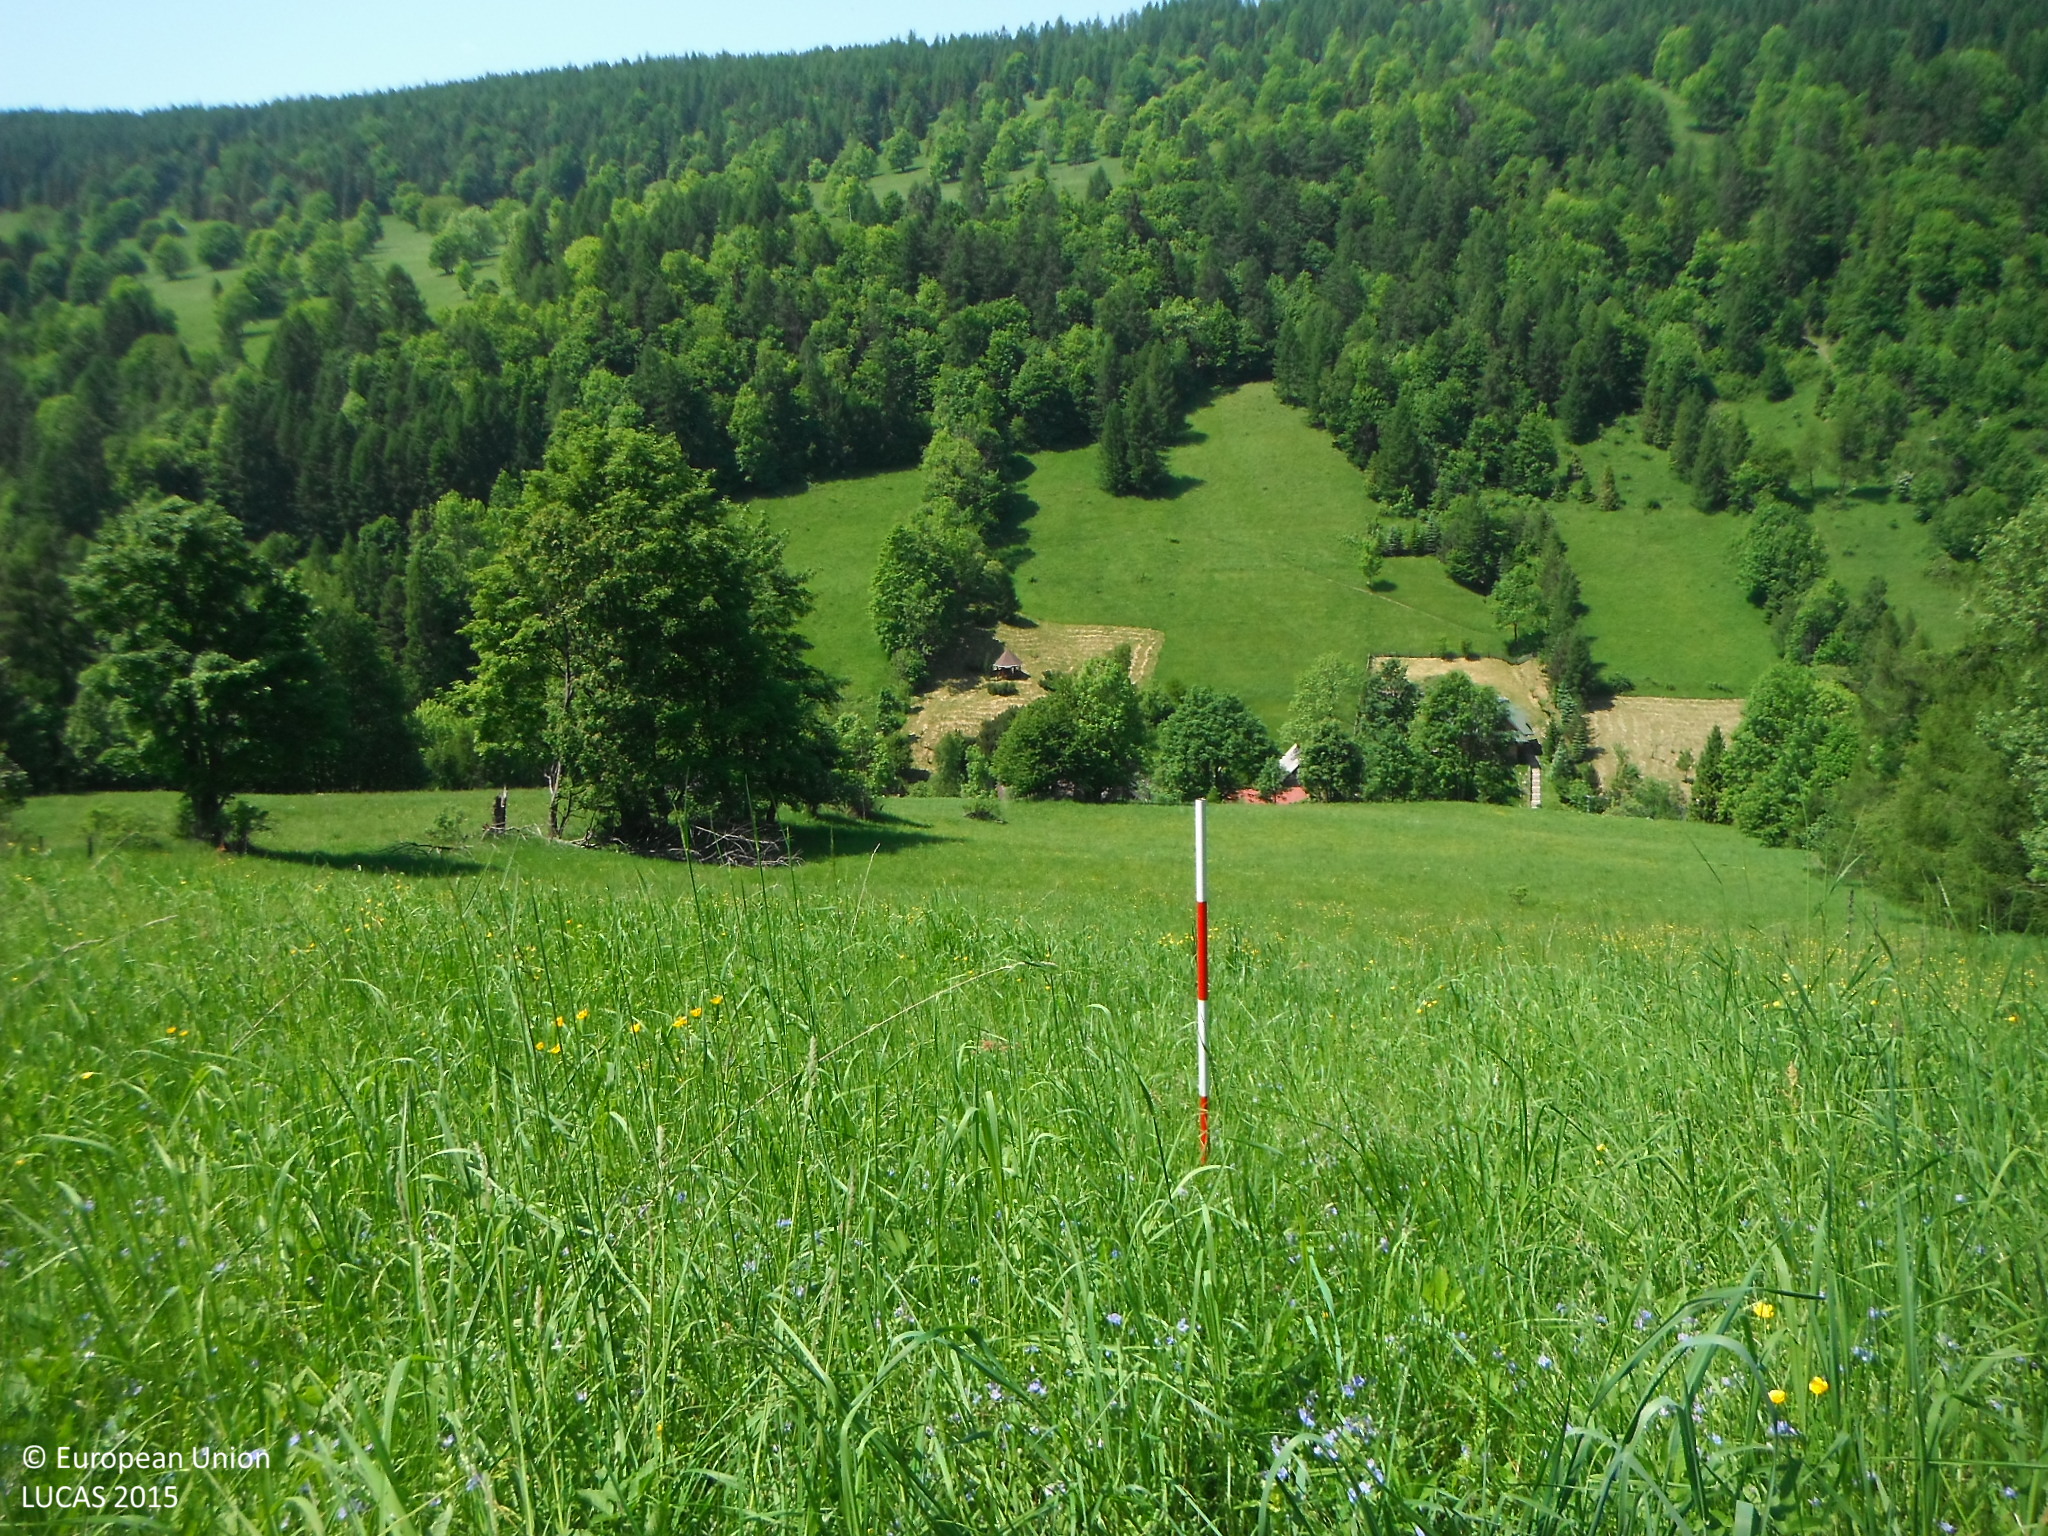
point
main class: Grassland
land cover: Grassland without tree/shrub cover
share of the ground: > 75 %
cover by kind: herbaceous plants 100 %
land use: Agriculture (excluding fallow land and kitchen gardens)
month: June
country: SK
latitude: 49.2963
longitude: 20.3341
